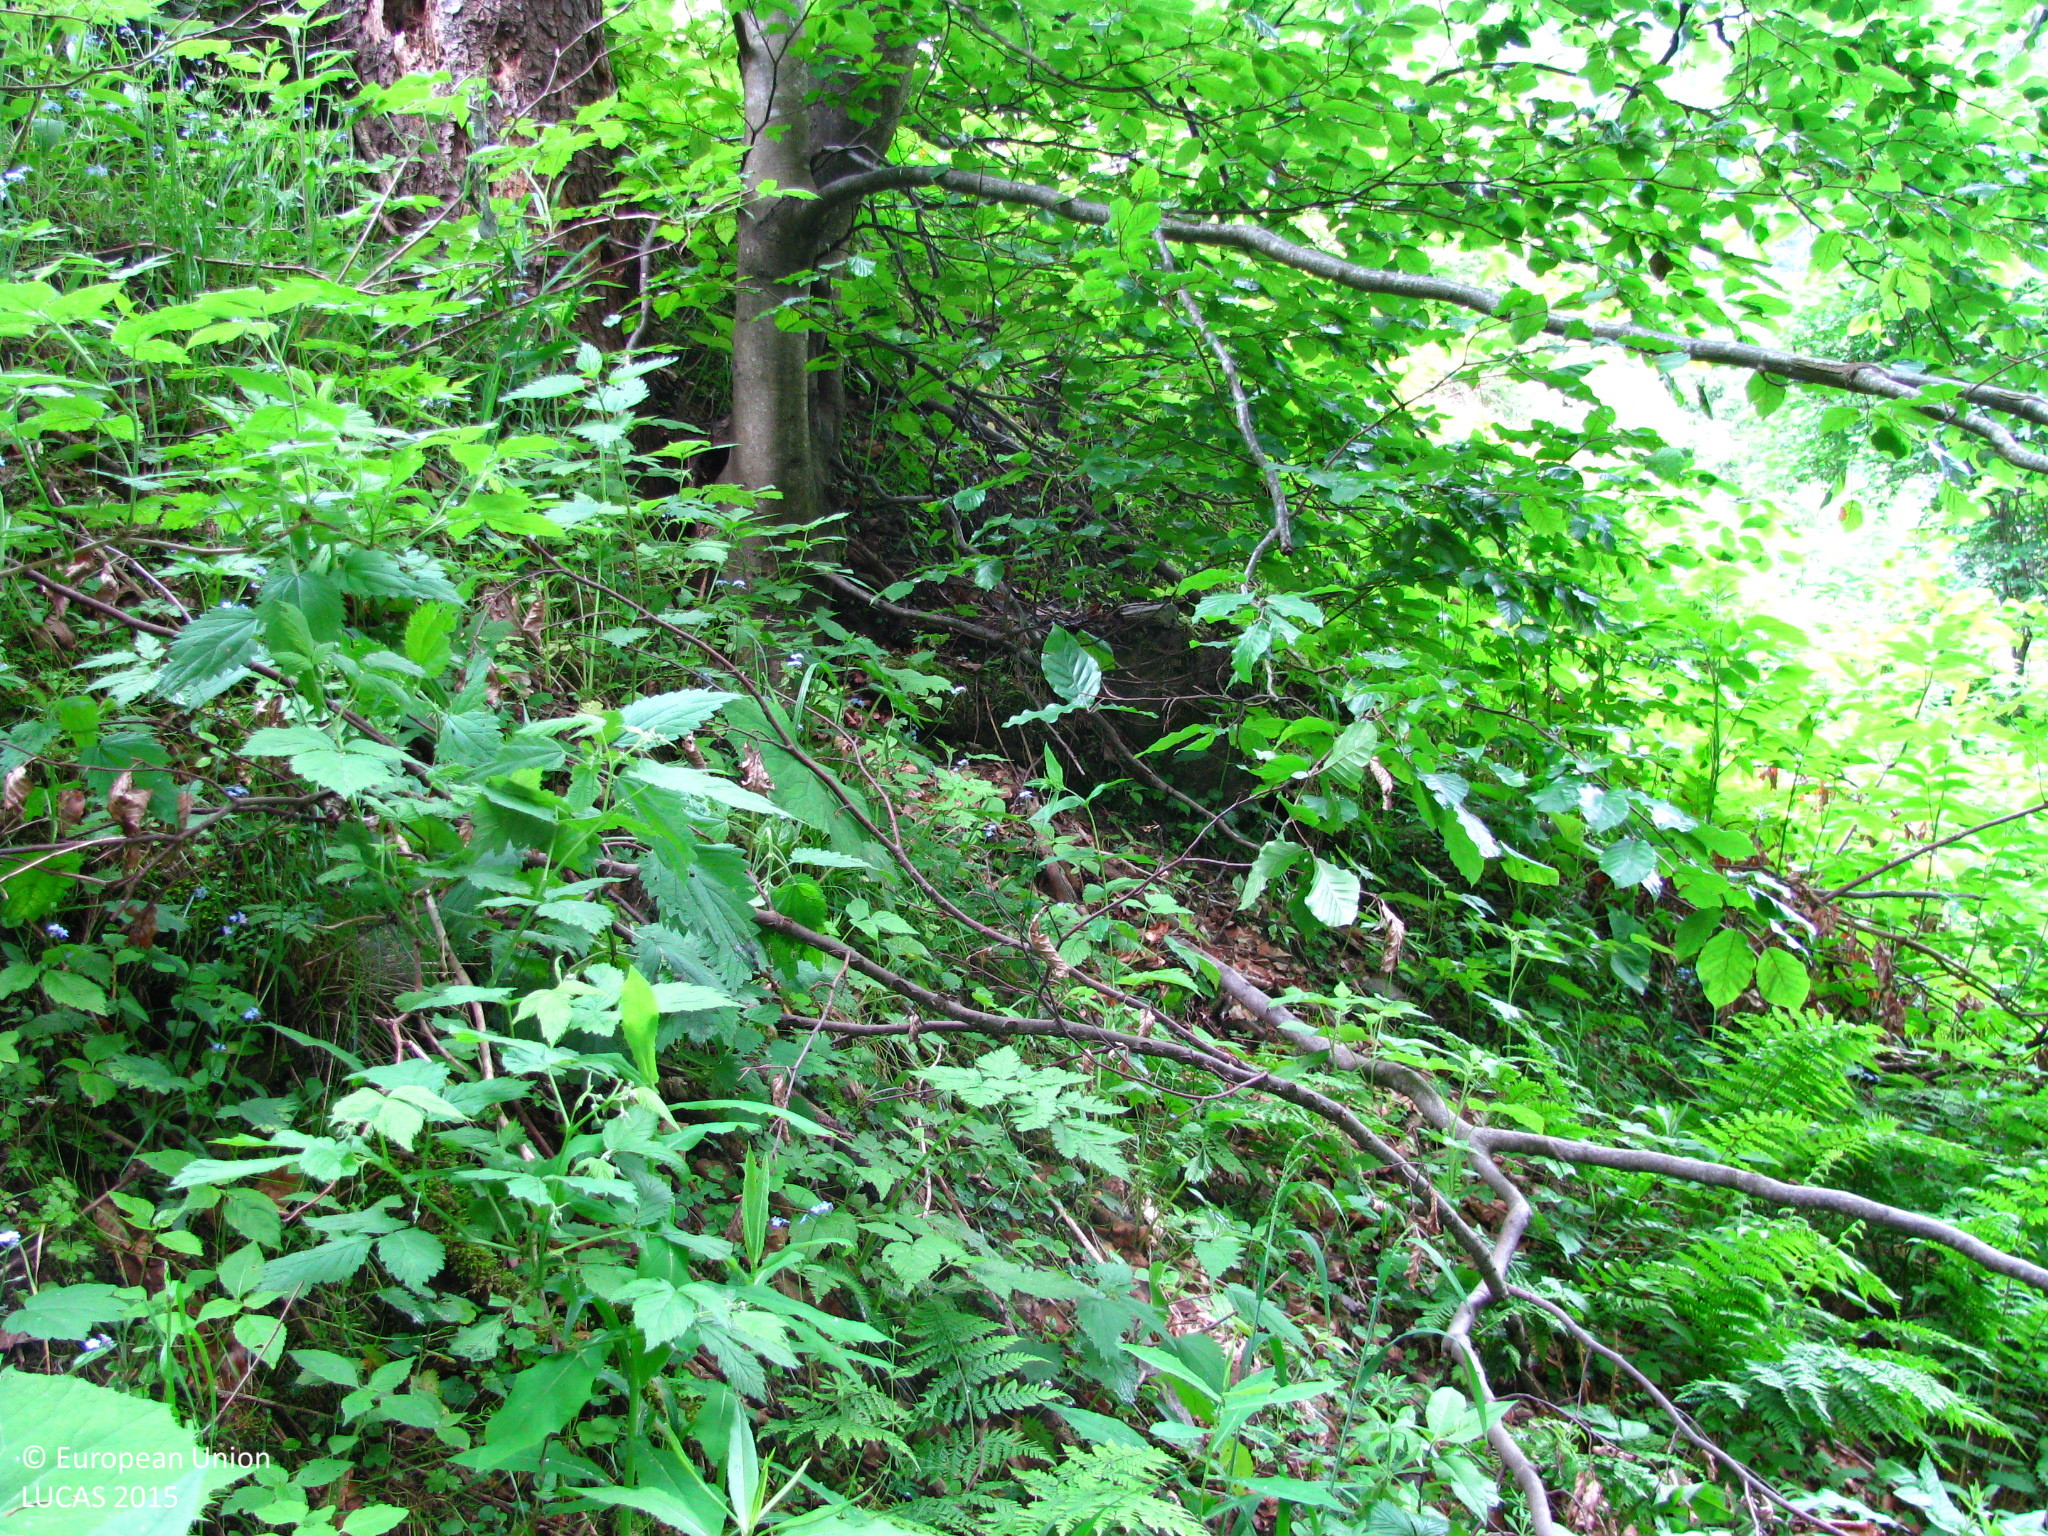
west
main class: Woodland
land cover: Spruce dominated mixed woodland
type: mountainous beech forest
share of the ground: > 75 %
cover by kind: broadleaved forest trees 45 %, coniferous forest trees 40 %, herbaceous plants 10 %, lichens and mosses 5 %
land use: Forestry
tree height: > 5 m
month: June
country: AT
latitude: 47.4622
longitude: 14.9744
